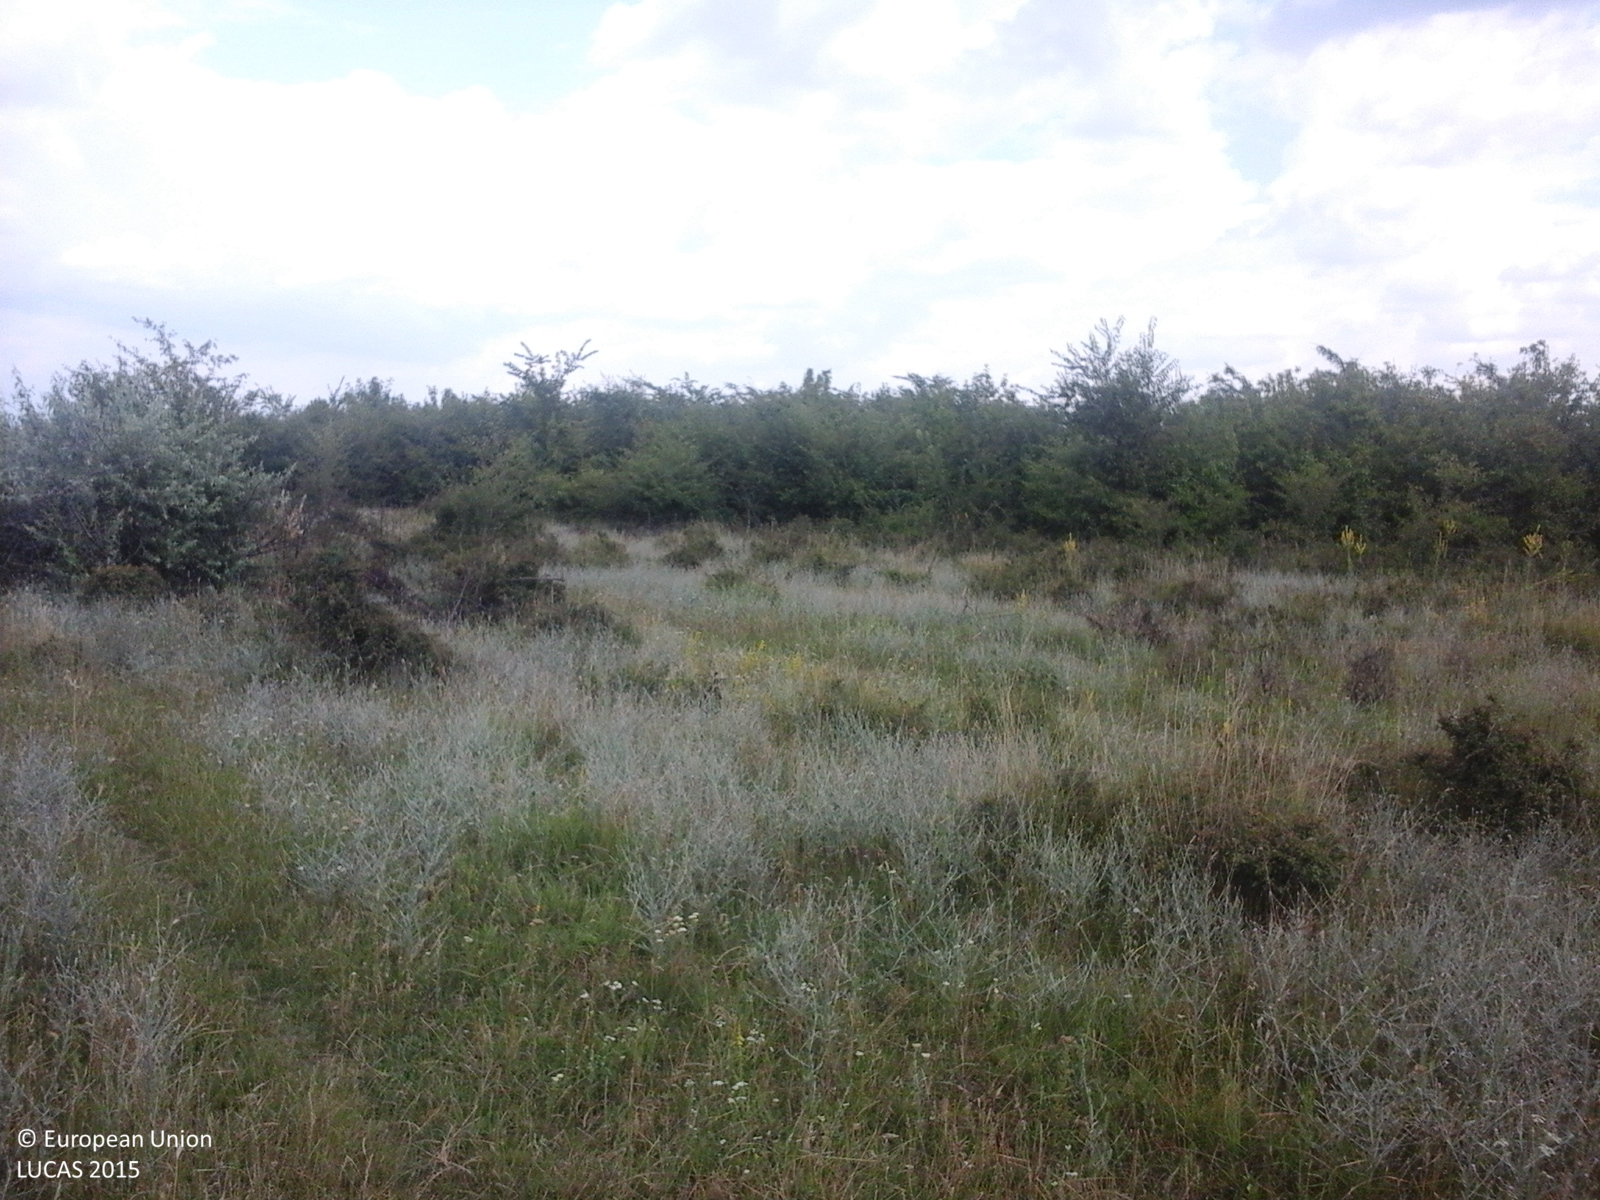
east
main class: Shrubland
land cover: Shrubland with sparse tree cover
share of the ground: > 75 %
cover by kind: shrubs 75 %, herbaceous plants 20 %, broadleaved forest trees 5 %
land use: Abandoned areas
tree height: < 5 m
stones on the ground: < 10 %
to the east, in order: Shrubland with sparse tree cover; Tracks; Sunflower
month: July
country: RO
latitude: 44.1718
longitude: 25.2287
